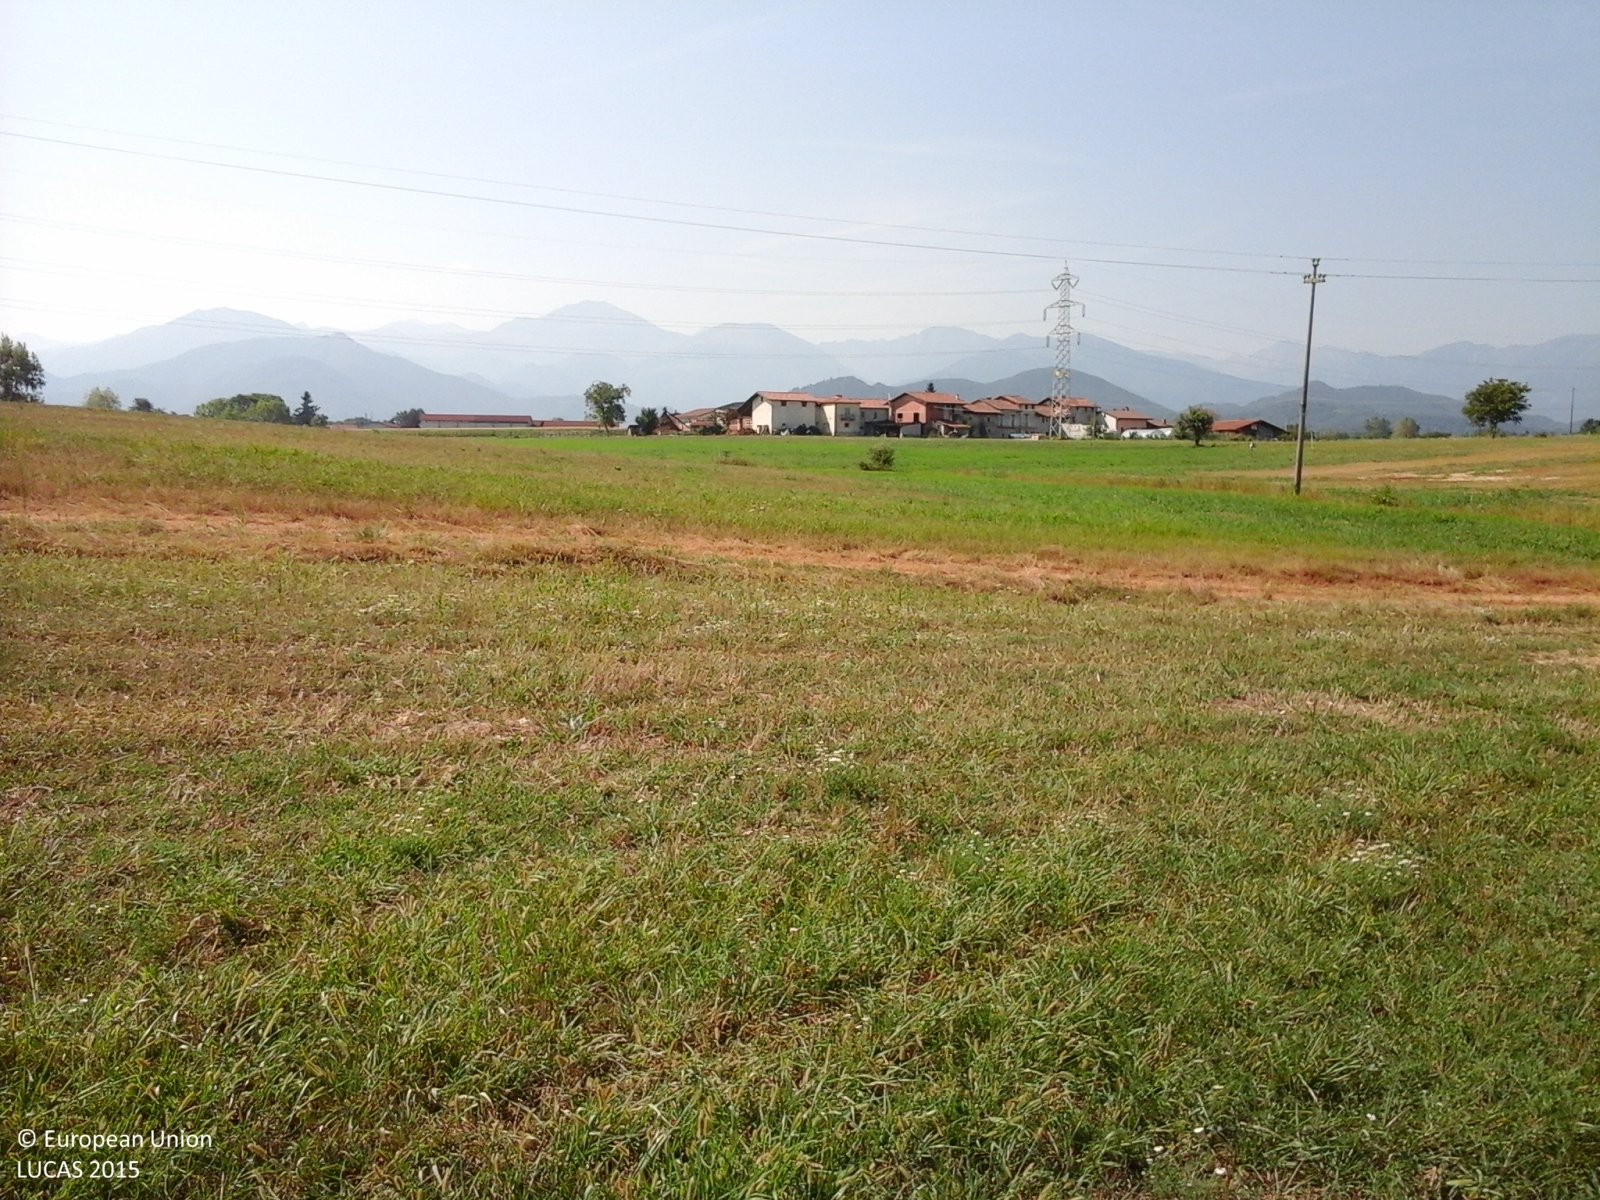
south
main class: Cropland
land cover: Common wheat
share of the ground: > 75 %
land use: Agriculture (excluding fallow land and kitchen gardens)
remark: Harvested field
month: August
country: IT
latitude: 44.3805
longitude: 7.7581
